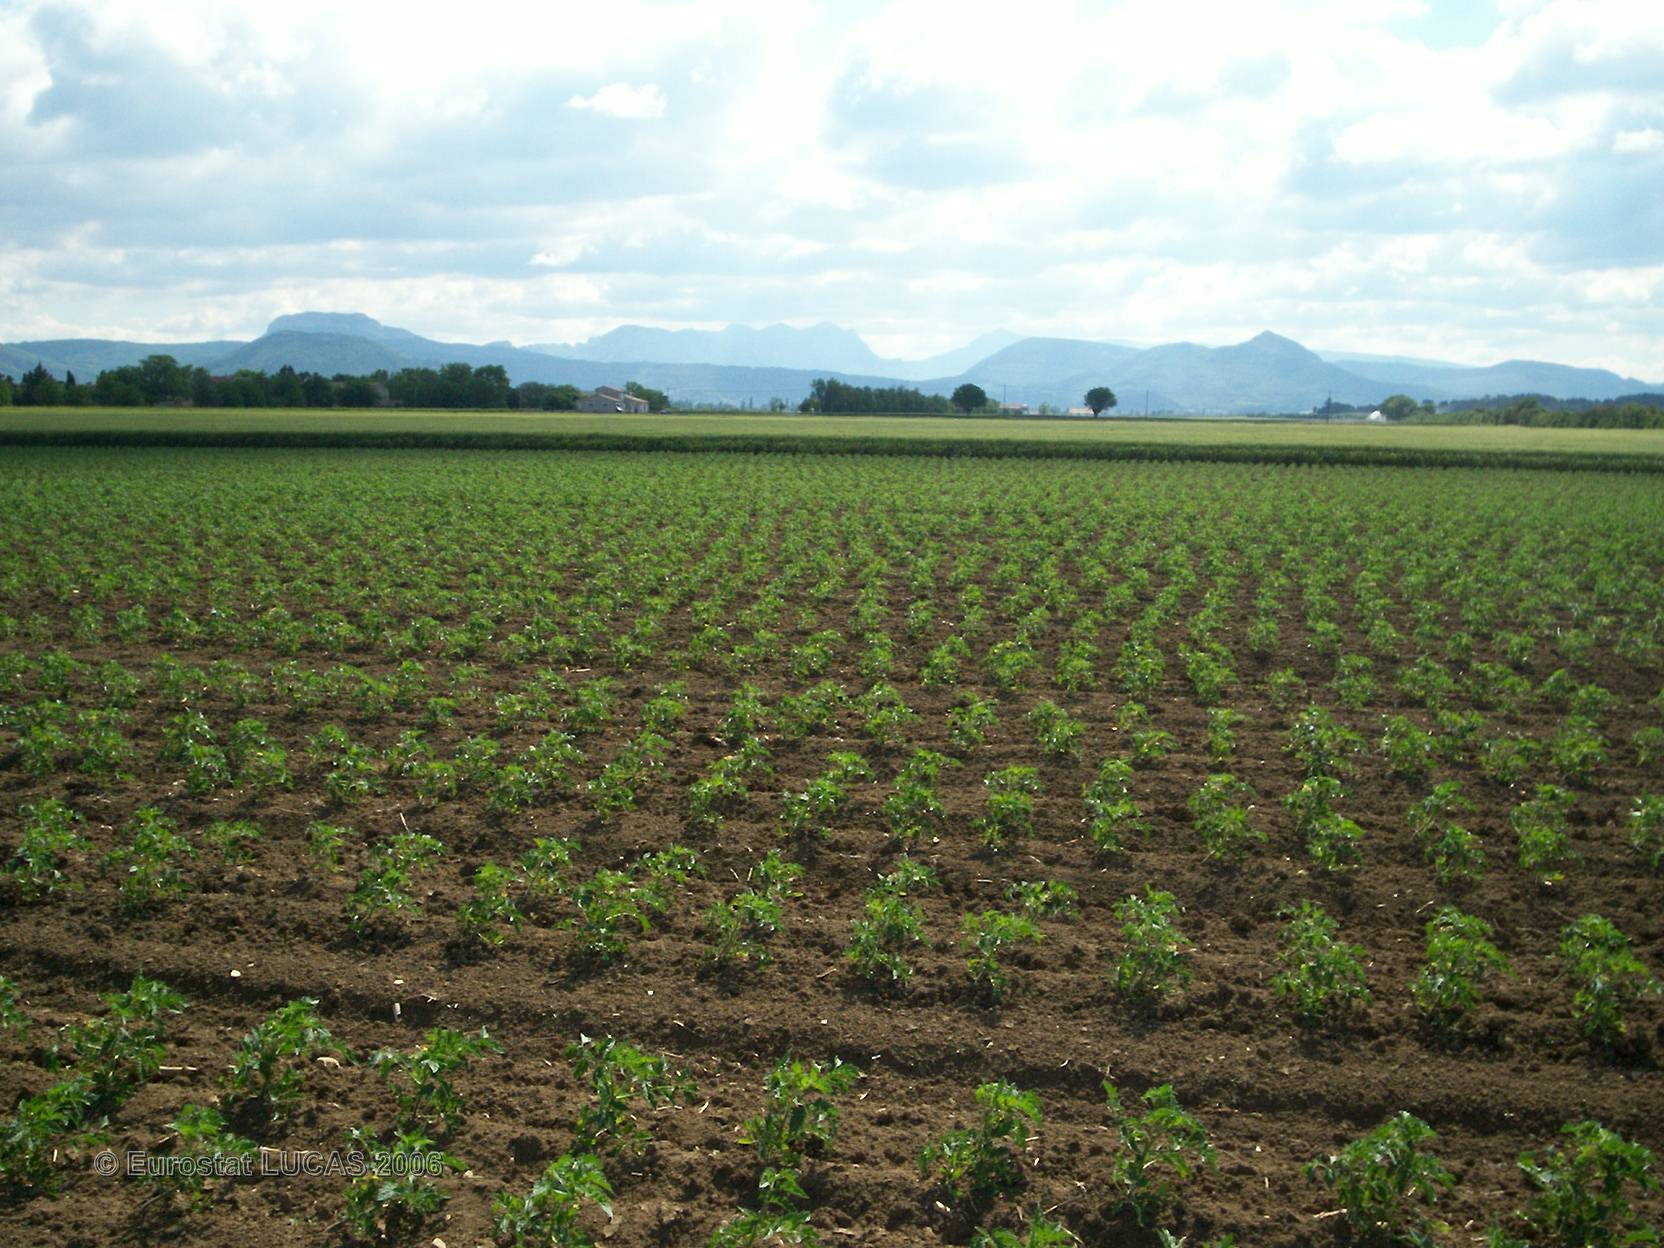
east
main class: Cropland
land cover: Tomatoes
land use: Agriculture (excluding fallow land and kitchen gardens)
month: May
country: FR
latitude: 44.6228
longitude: 4.9022
